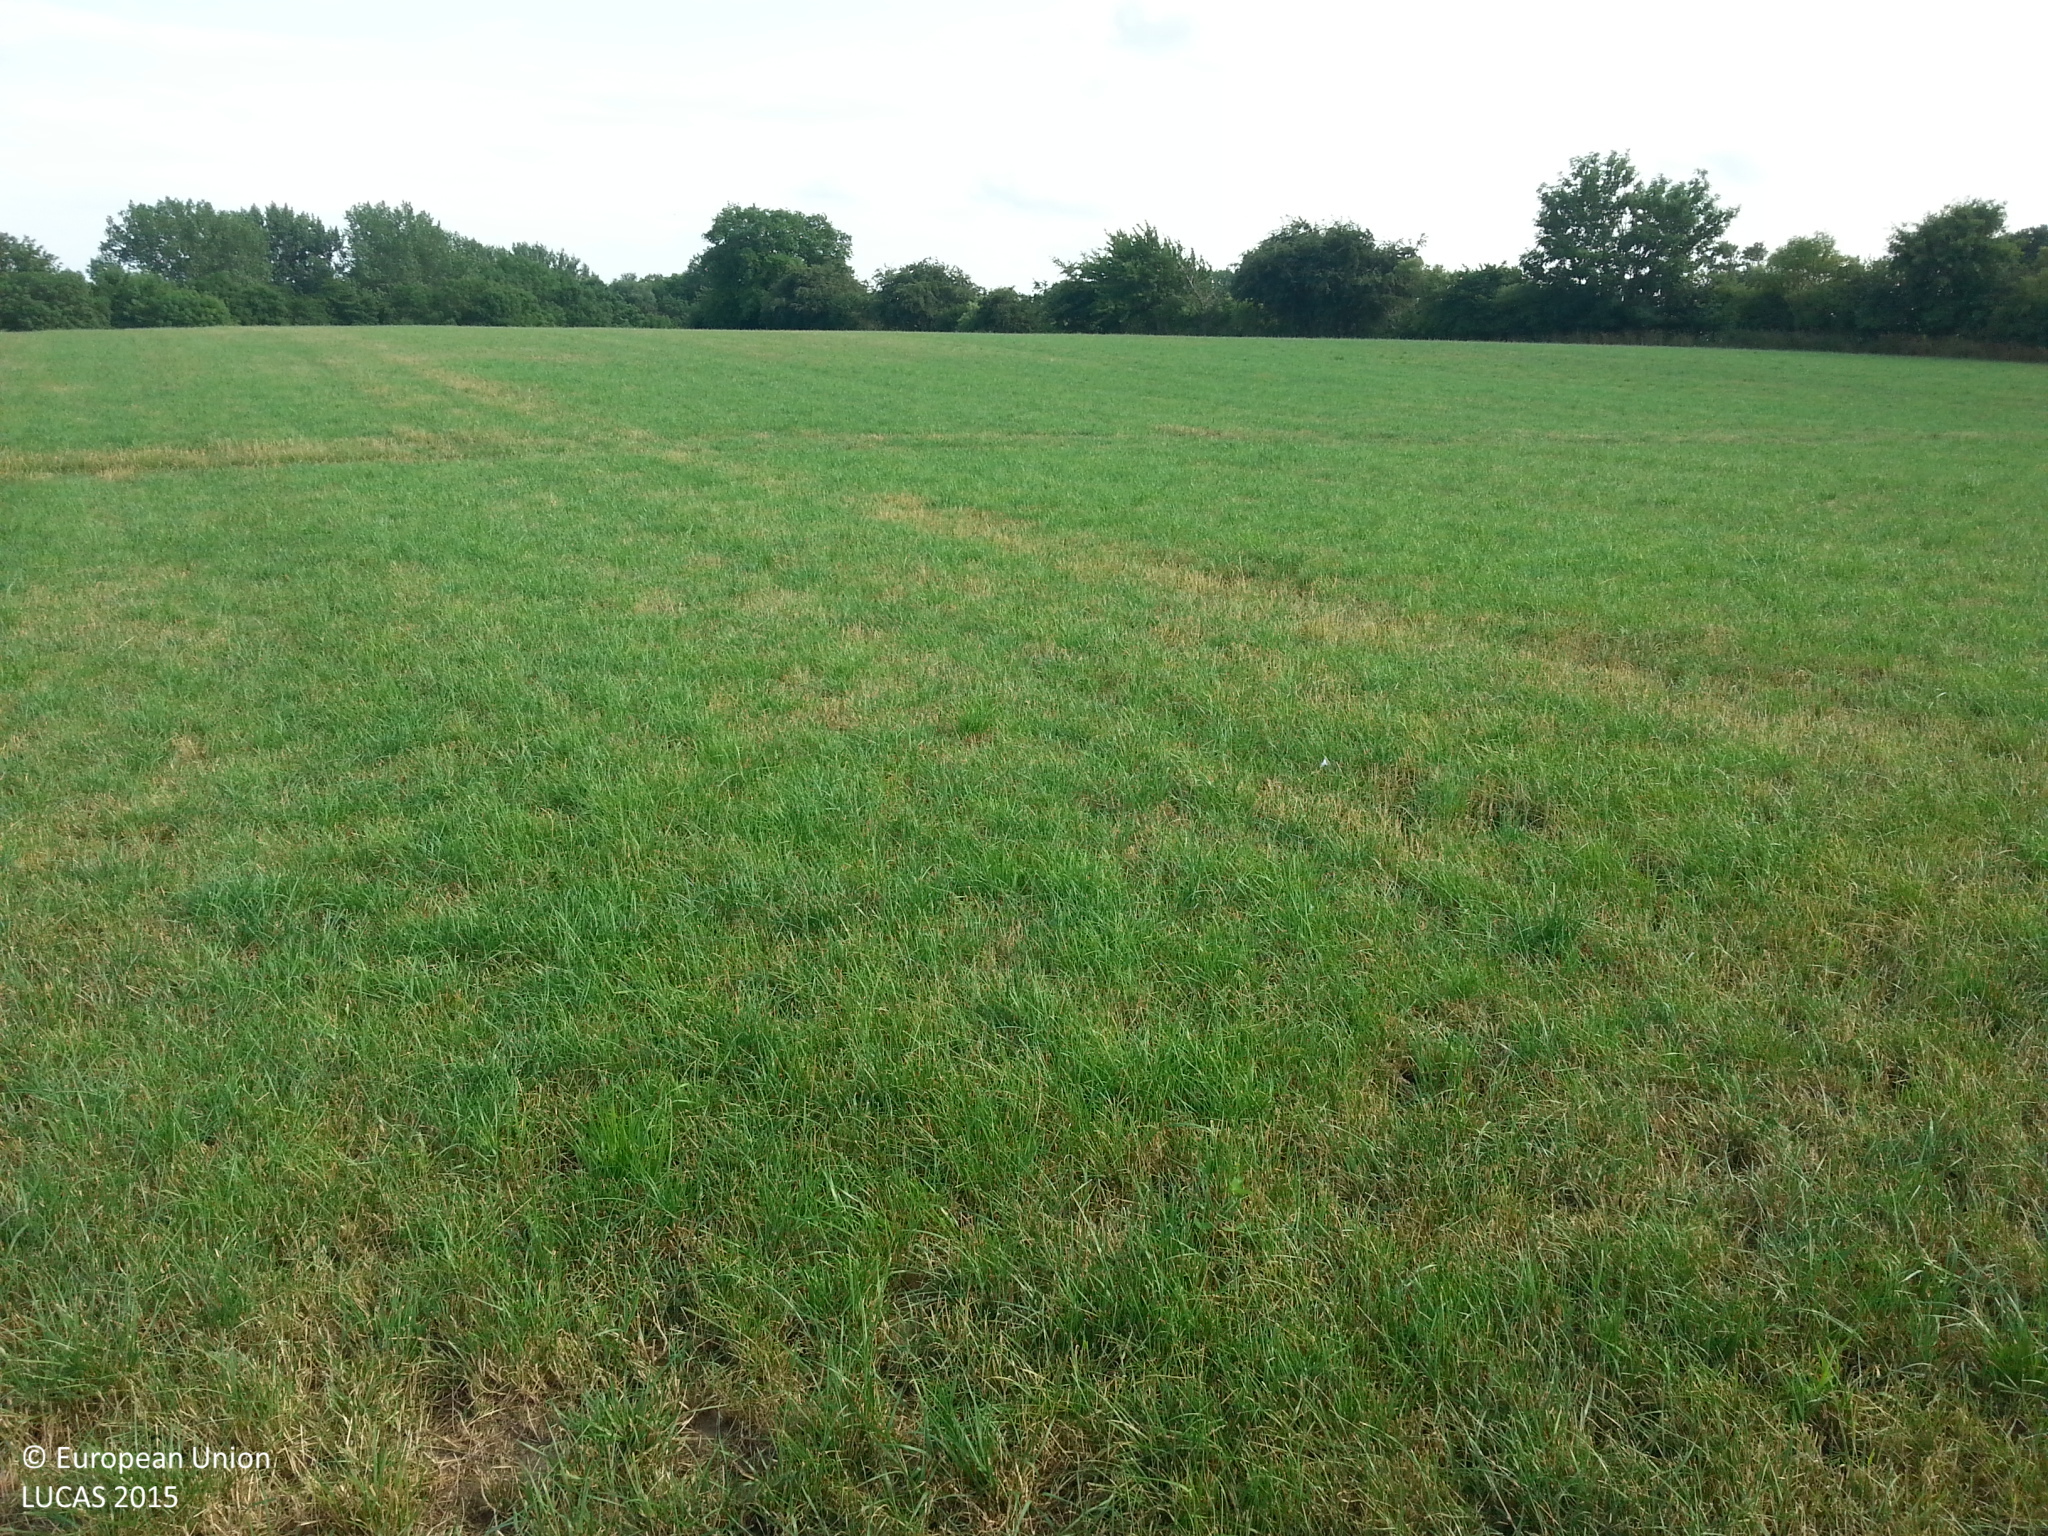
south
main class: Grassland
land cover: Grassland without tree/shrub cover
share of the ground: > 75 %
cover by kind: herbaceous plants 100 %
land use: Agriculture (excluding fallow land and kitchen gardens)
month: July
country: DE
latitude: 54.0076
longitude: 11.1438
